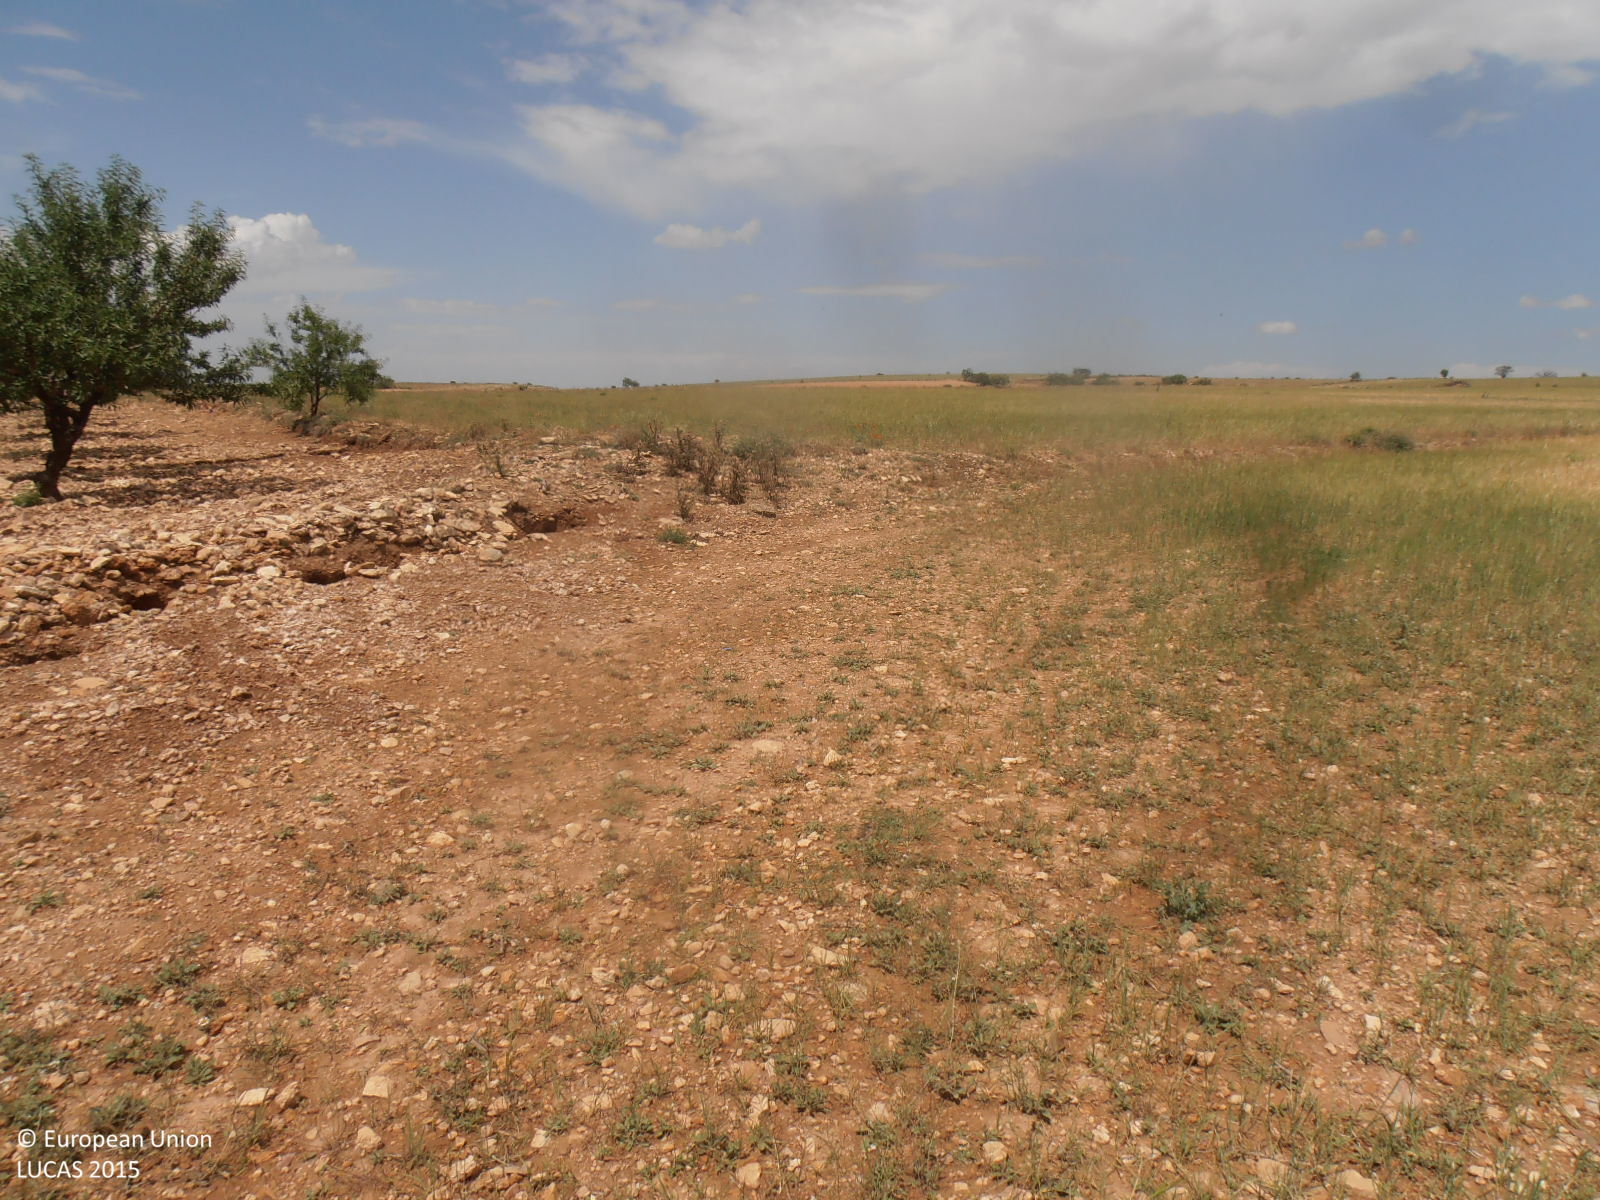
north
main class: Cropland
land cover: Barley
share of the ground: > 75 %
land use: Agriculture (excluding fallow land and kitchen gardens)
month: June
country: ES
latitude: 41.4640
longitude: -1.2173
